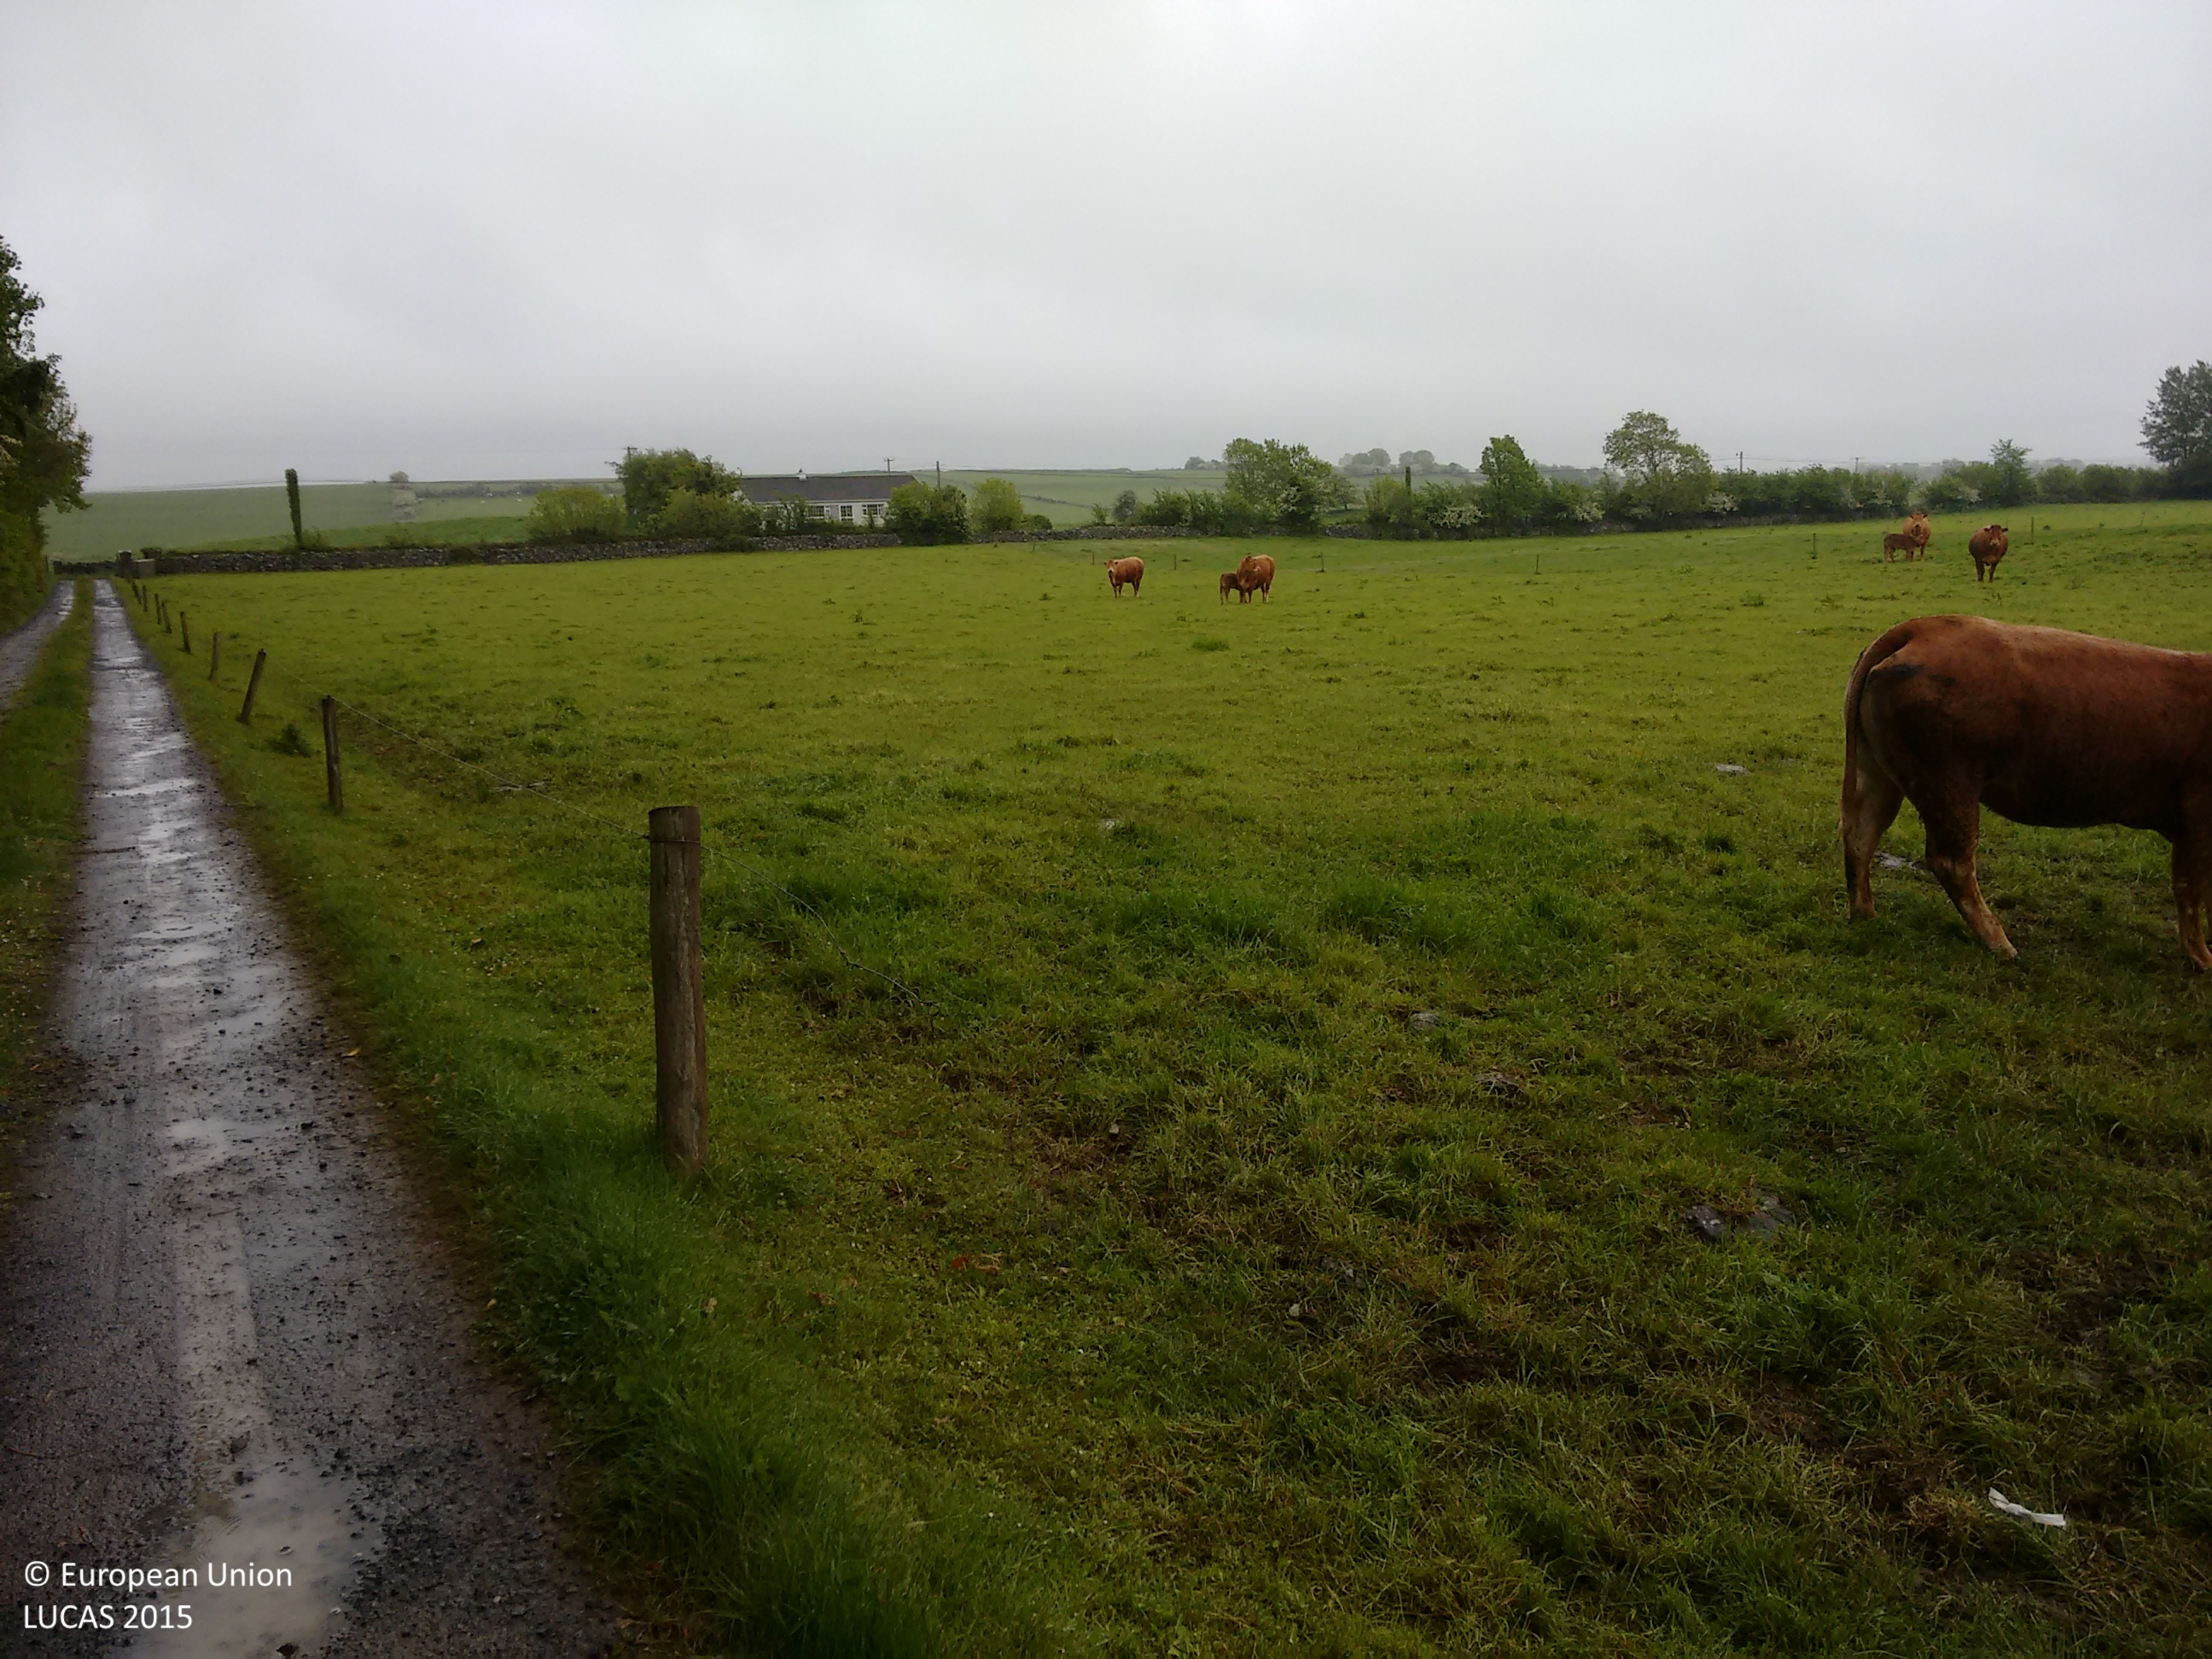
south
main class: Grassland
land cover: Grassland without tree/shrub cover
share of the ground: > 75 %
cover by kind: herbaceous plants 100 %
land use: Agriculture (excluding fallow land and kitchen gardens)
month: May
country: IE
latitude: 53.1108
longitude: -8.8041
